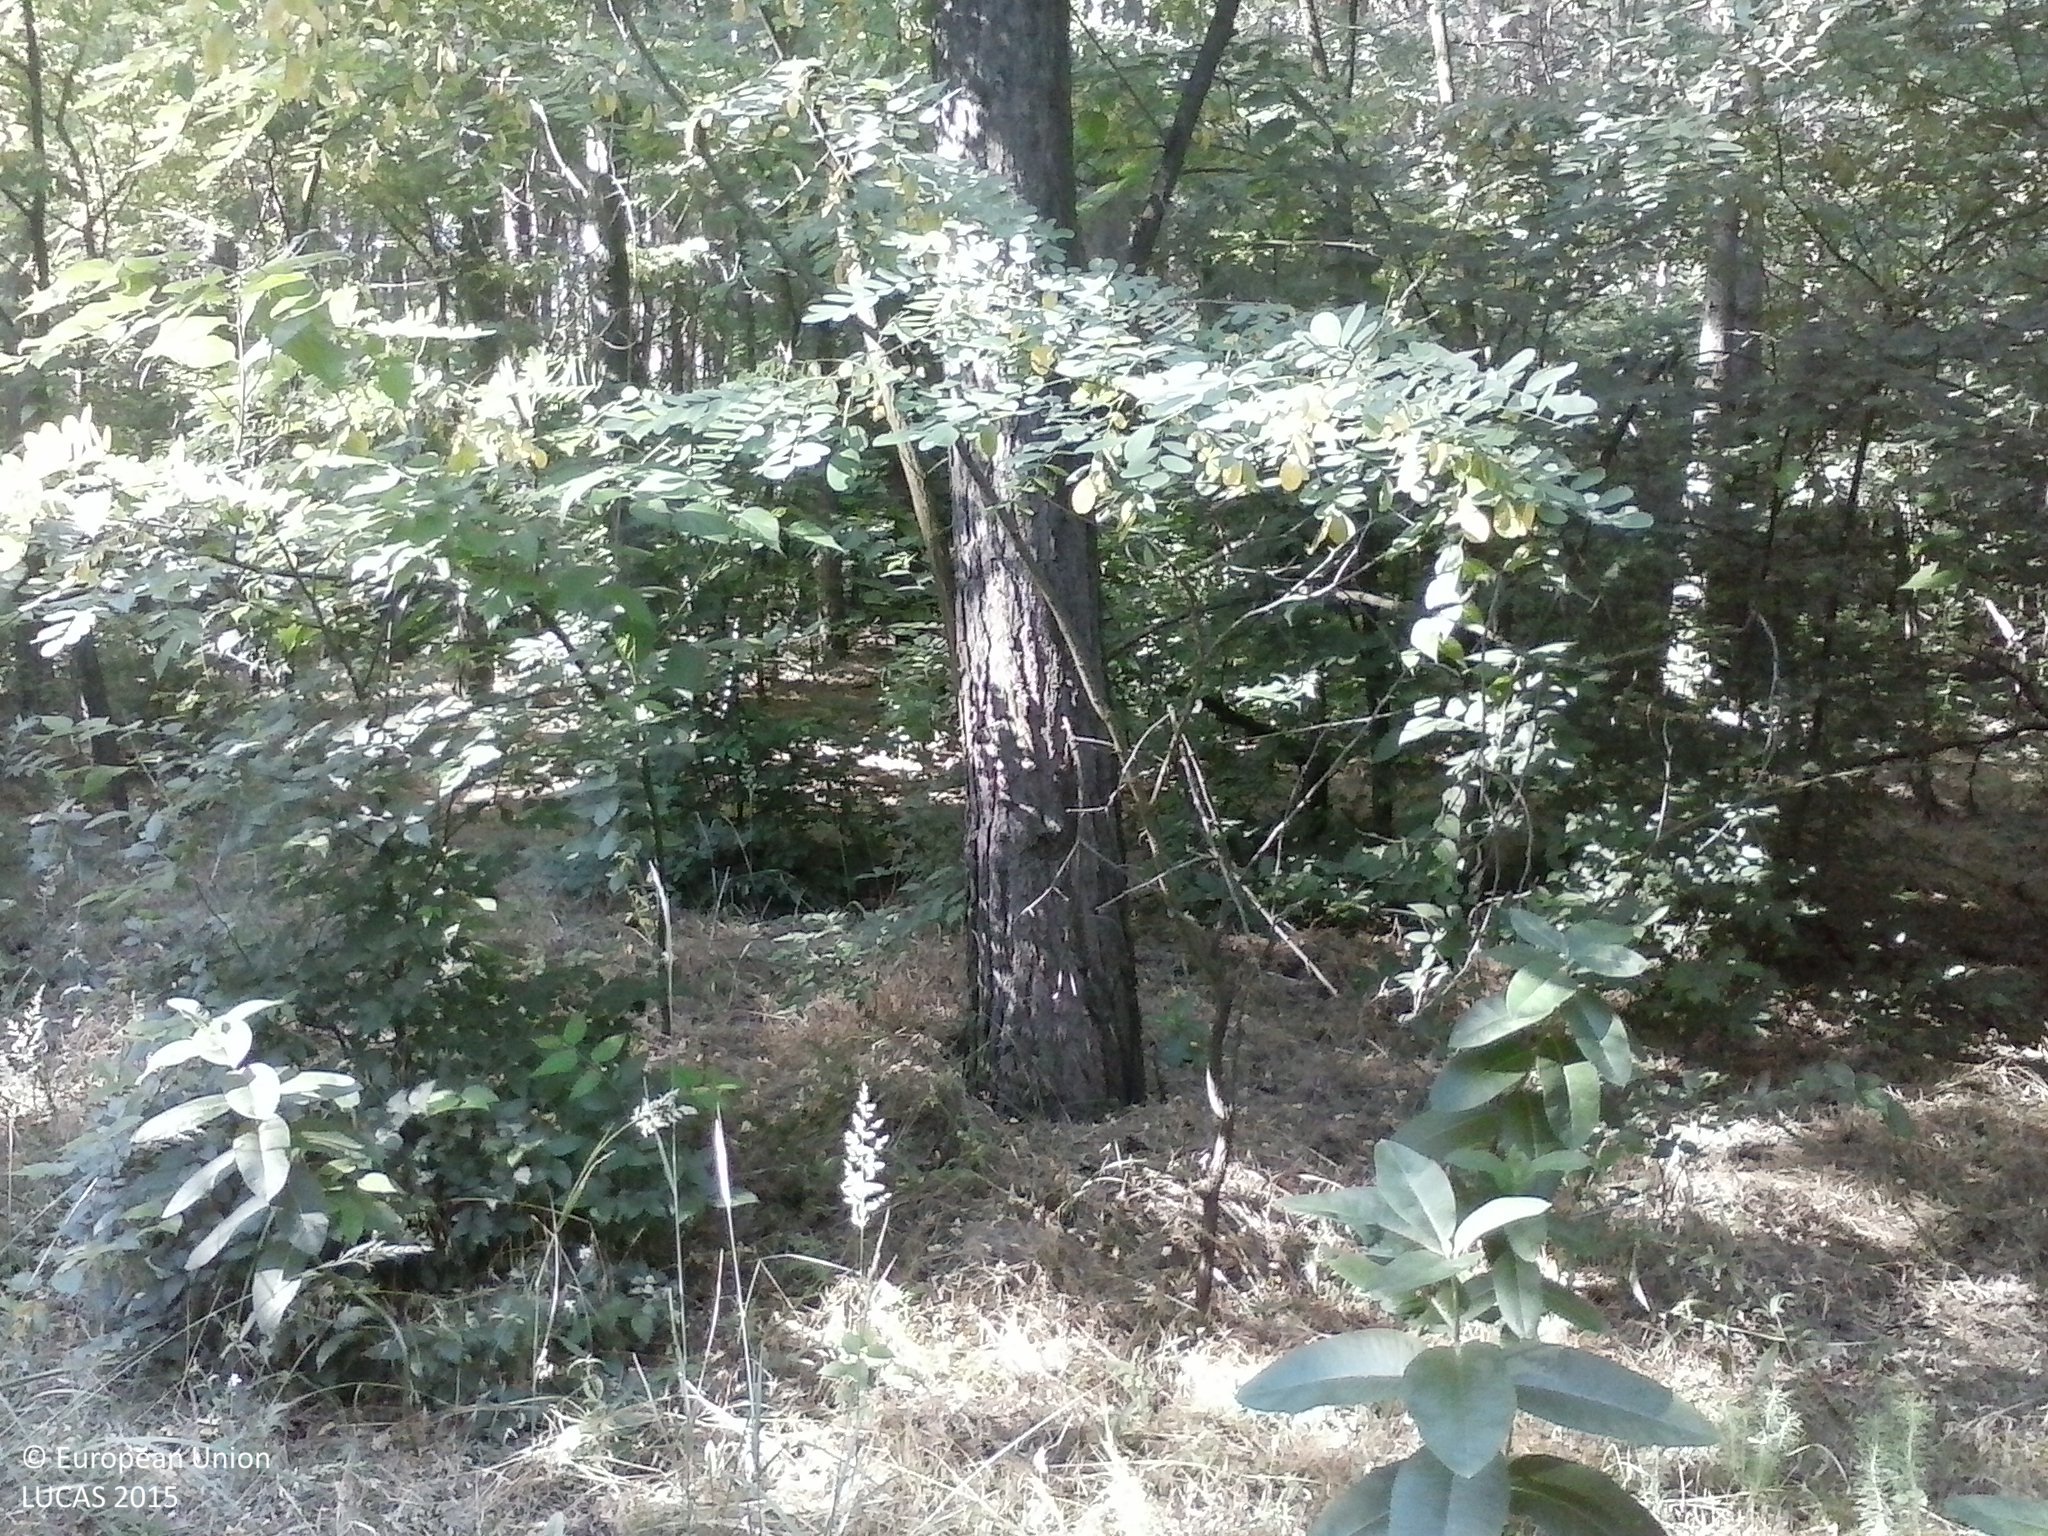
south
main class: Woodland
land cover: Pine dominated coniferous woodland
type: hemiboreal forest and nemoral coniferous forest and mixed broadleaved-coniferous forest
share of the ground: > 75 %
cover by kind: coniferous forest trees 70 %, broadleaved forest trees 20 %, shrubs 5 %, herbaceous plants 5 %
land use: Forestry
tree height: > 5 m
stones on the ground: < 10 %
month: July
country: HU
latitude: 46.3114
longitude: 19.6662
